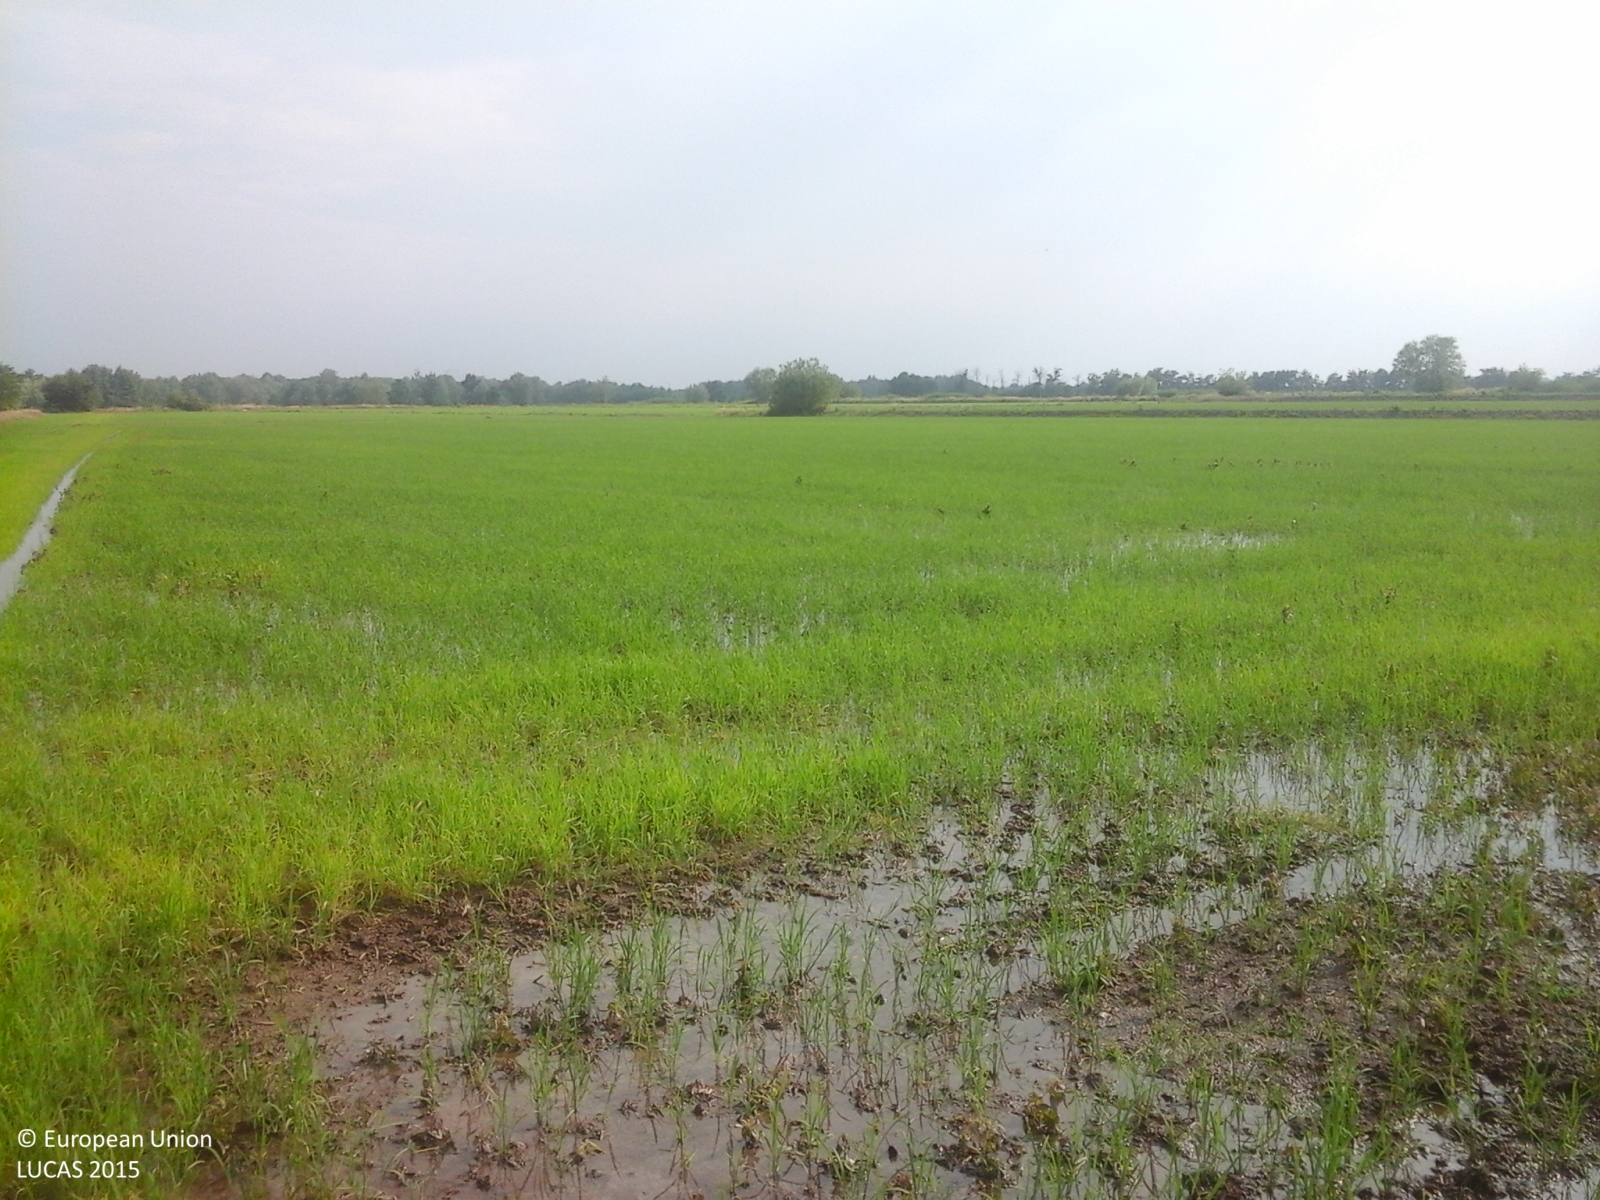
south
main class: Cropland
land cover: Rice
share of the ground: 50 - 75 %
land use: Agriculture (excluding fallow land and kitchen gardens)
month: June
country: IT
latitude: 45.4907
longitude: 8.3010
